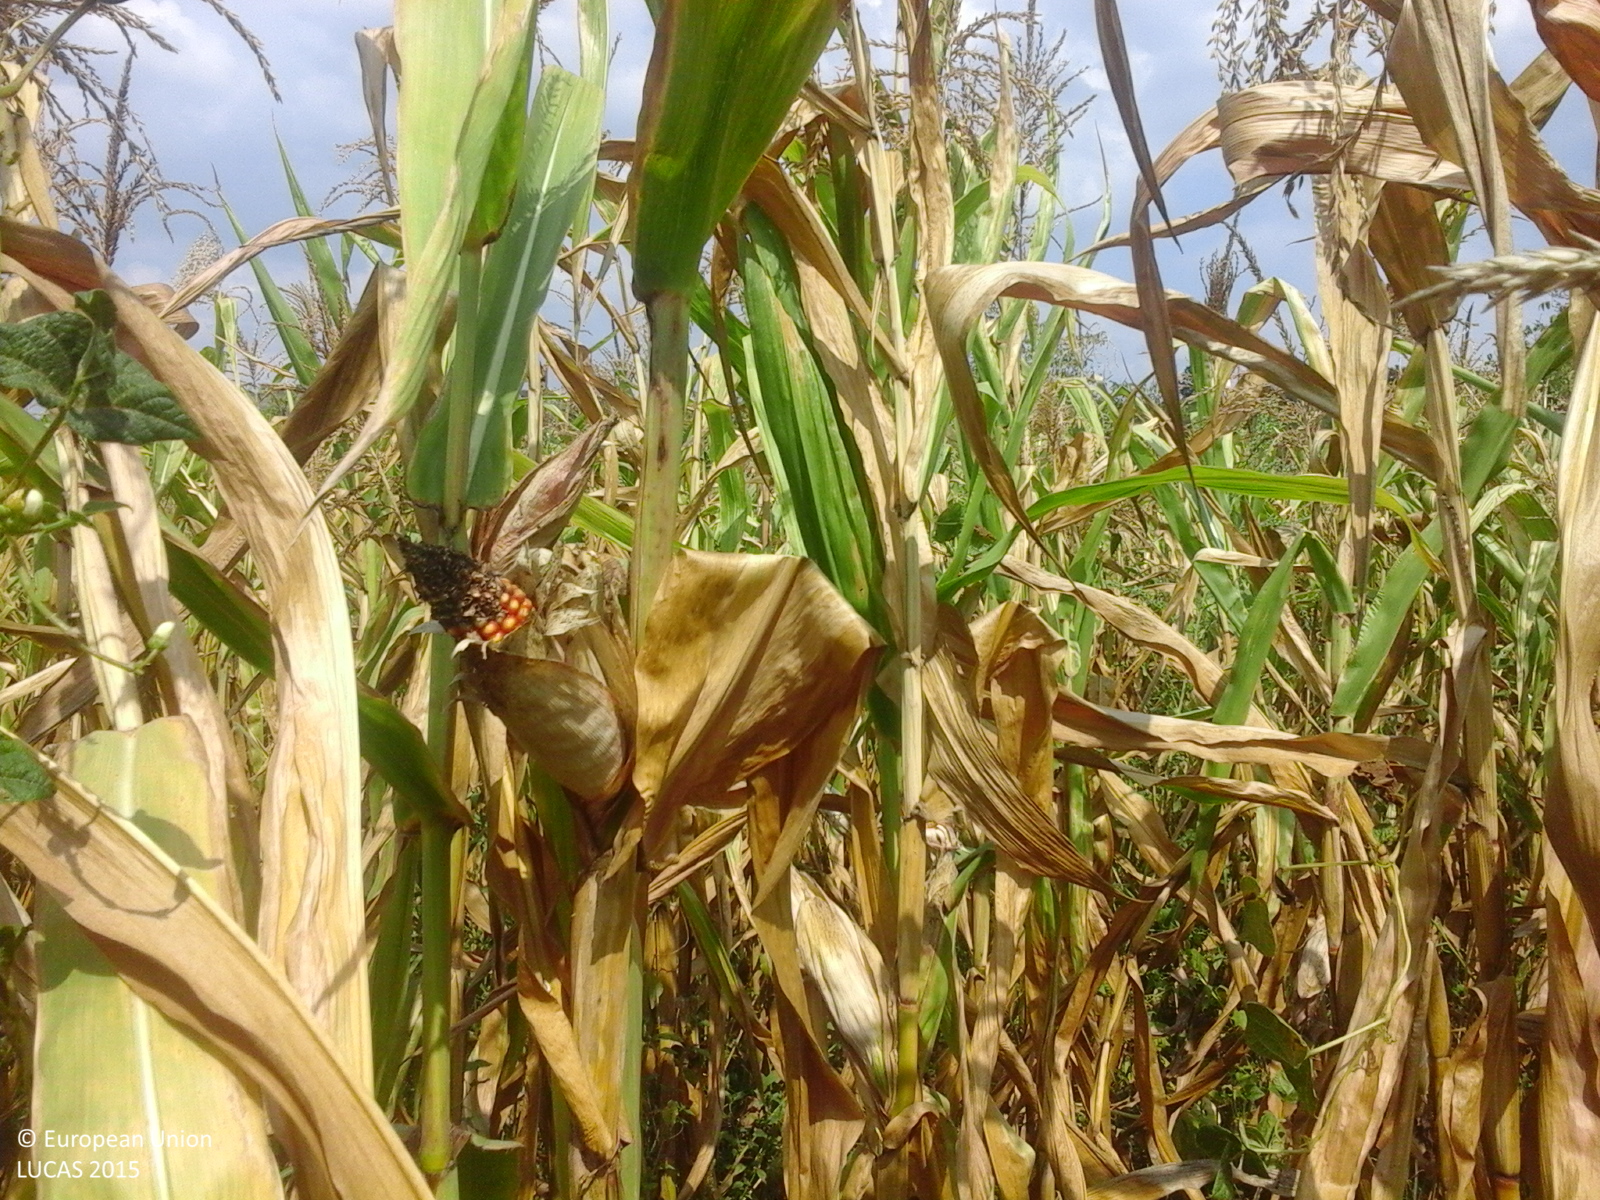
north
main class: Cropland
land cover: Maize
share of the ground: > 75 %
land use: Agriculture (excluding fallow land and kitchen gardens)
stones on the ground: < 10 %
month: August
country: RO
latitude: 46.3099
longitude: 22.1606
